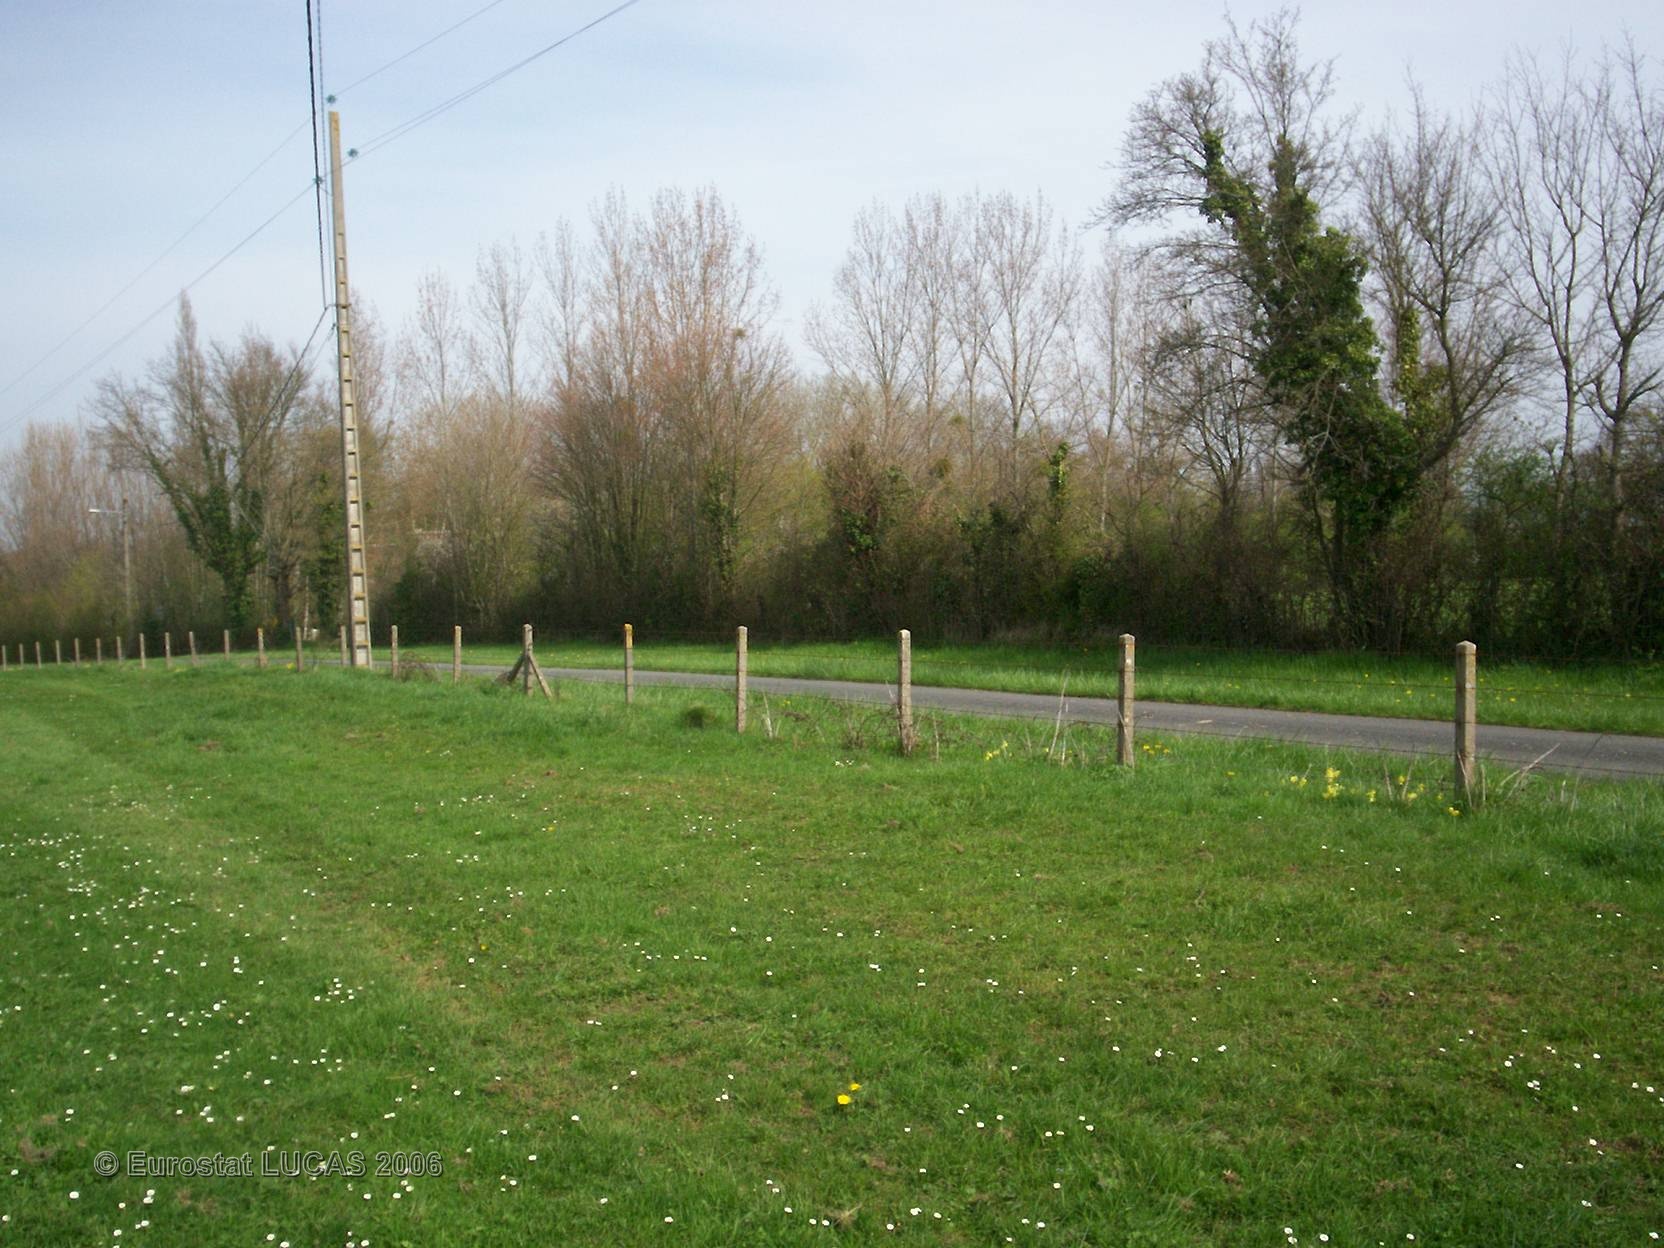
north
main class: Grassland
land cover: Grassland without tree/shrub cover
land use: Agriculture (excluding fallow land and kitchen gardens)
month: April
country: FR
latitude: 49.0291
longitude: -0.0841
